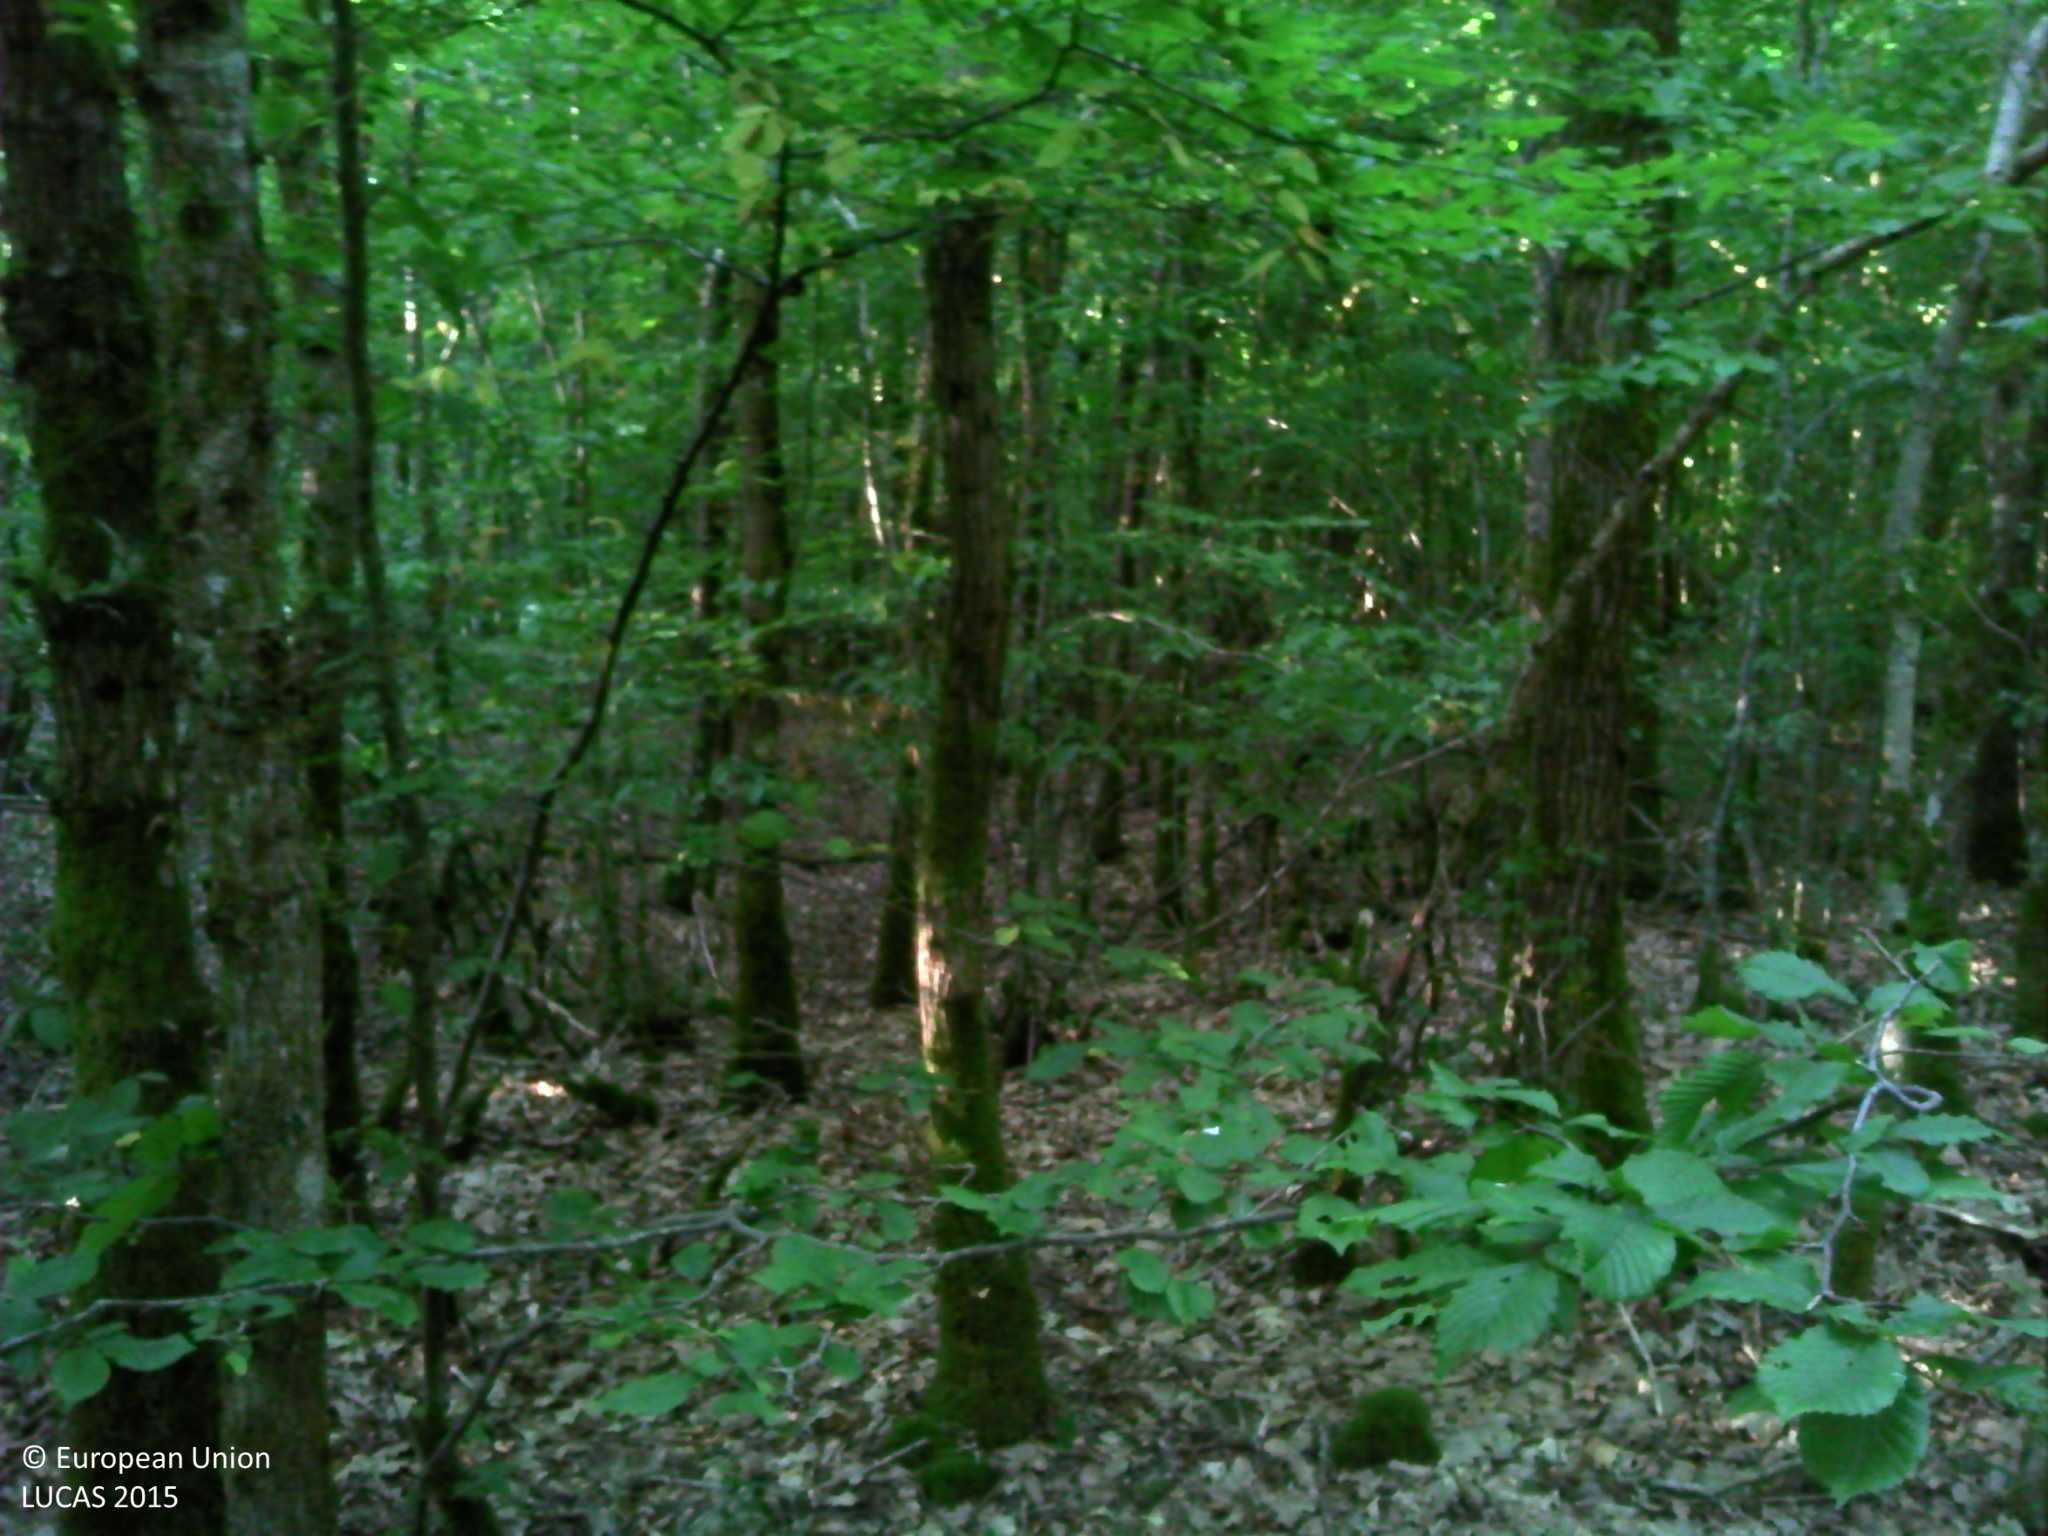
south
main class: Woodland
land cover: Broadleaved woodland
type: acidophilous oak and oak-birch forest
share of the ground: > 75 %
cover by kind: broadleaved forest trees 90 %, herbaceous plants 5 %, lichens and mosses 5 %
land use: Forestry
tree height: > 5 m
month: July
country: FR
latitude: 48.5305
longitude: 6.0322
